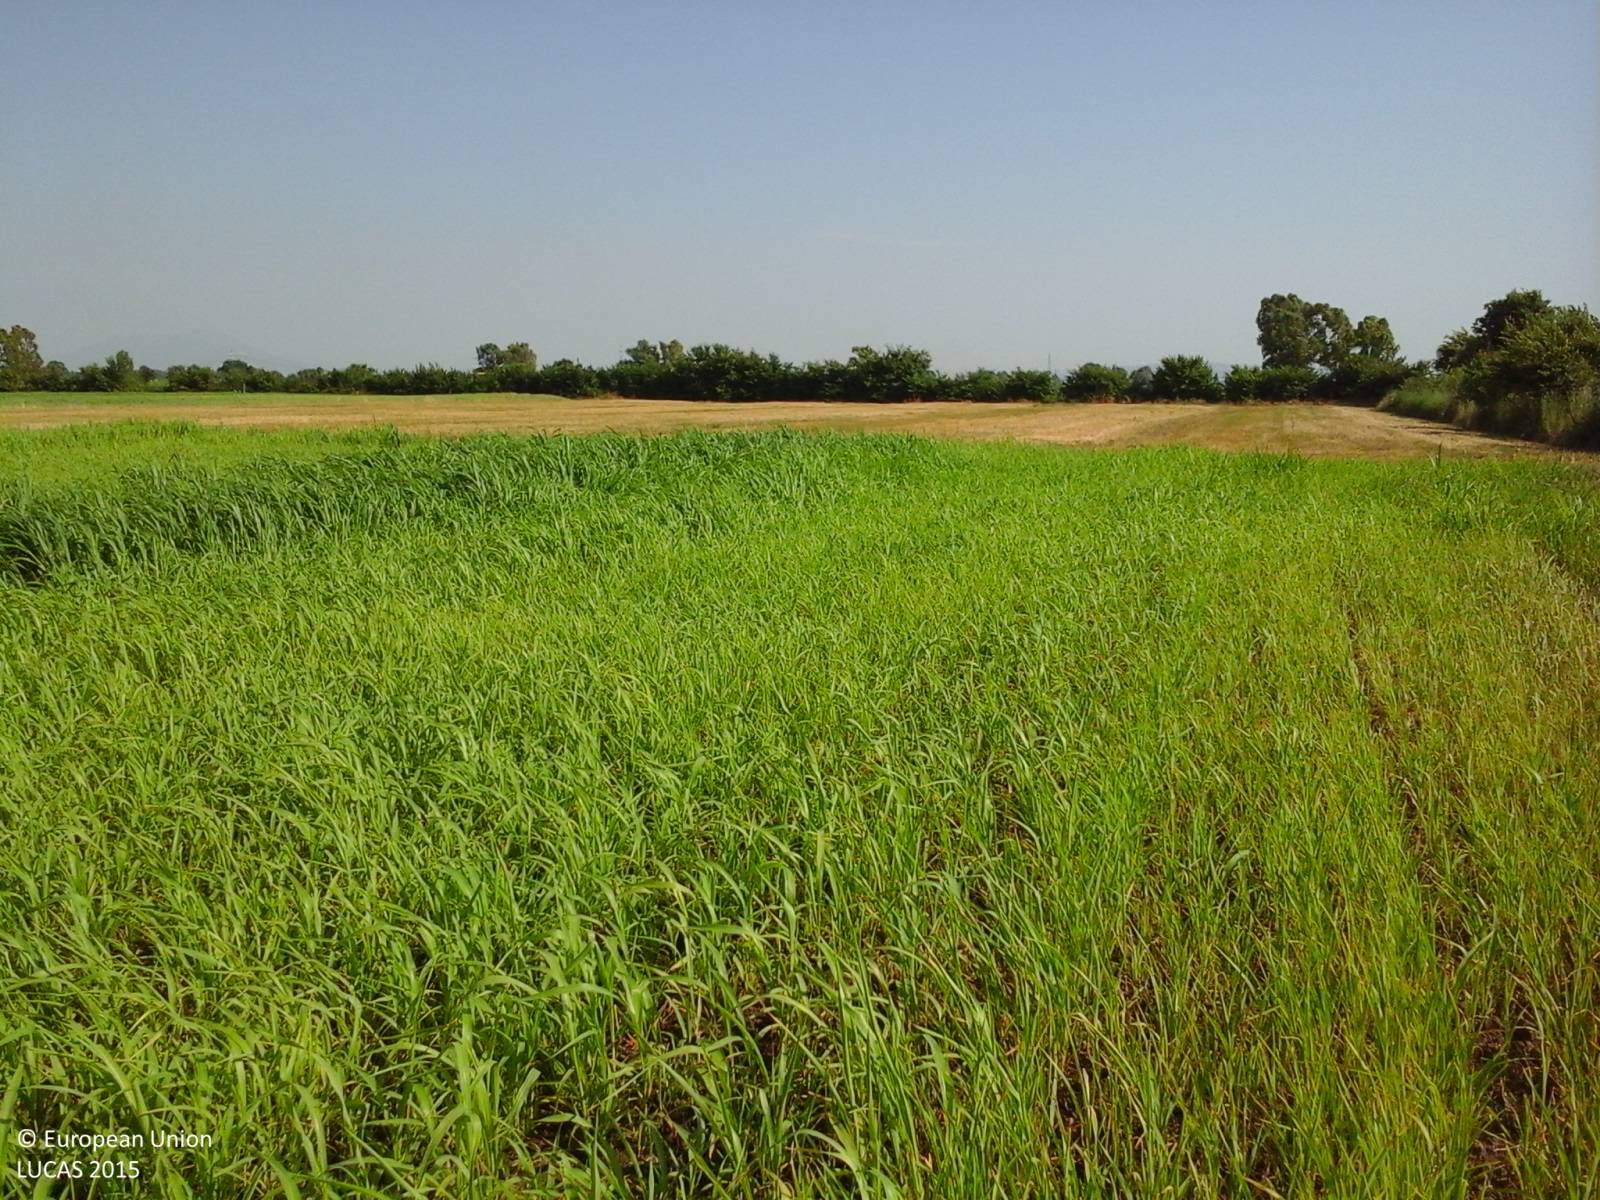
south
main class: Cropland
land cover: Other cereals
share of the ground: 50 - 75 %
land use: Agriculture (excluding fallow land and kitchen gardens)
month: July
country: IT
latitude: 41.0487
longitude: 14.1591
